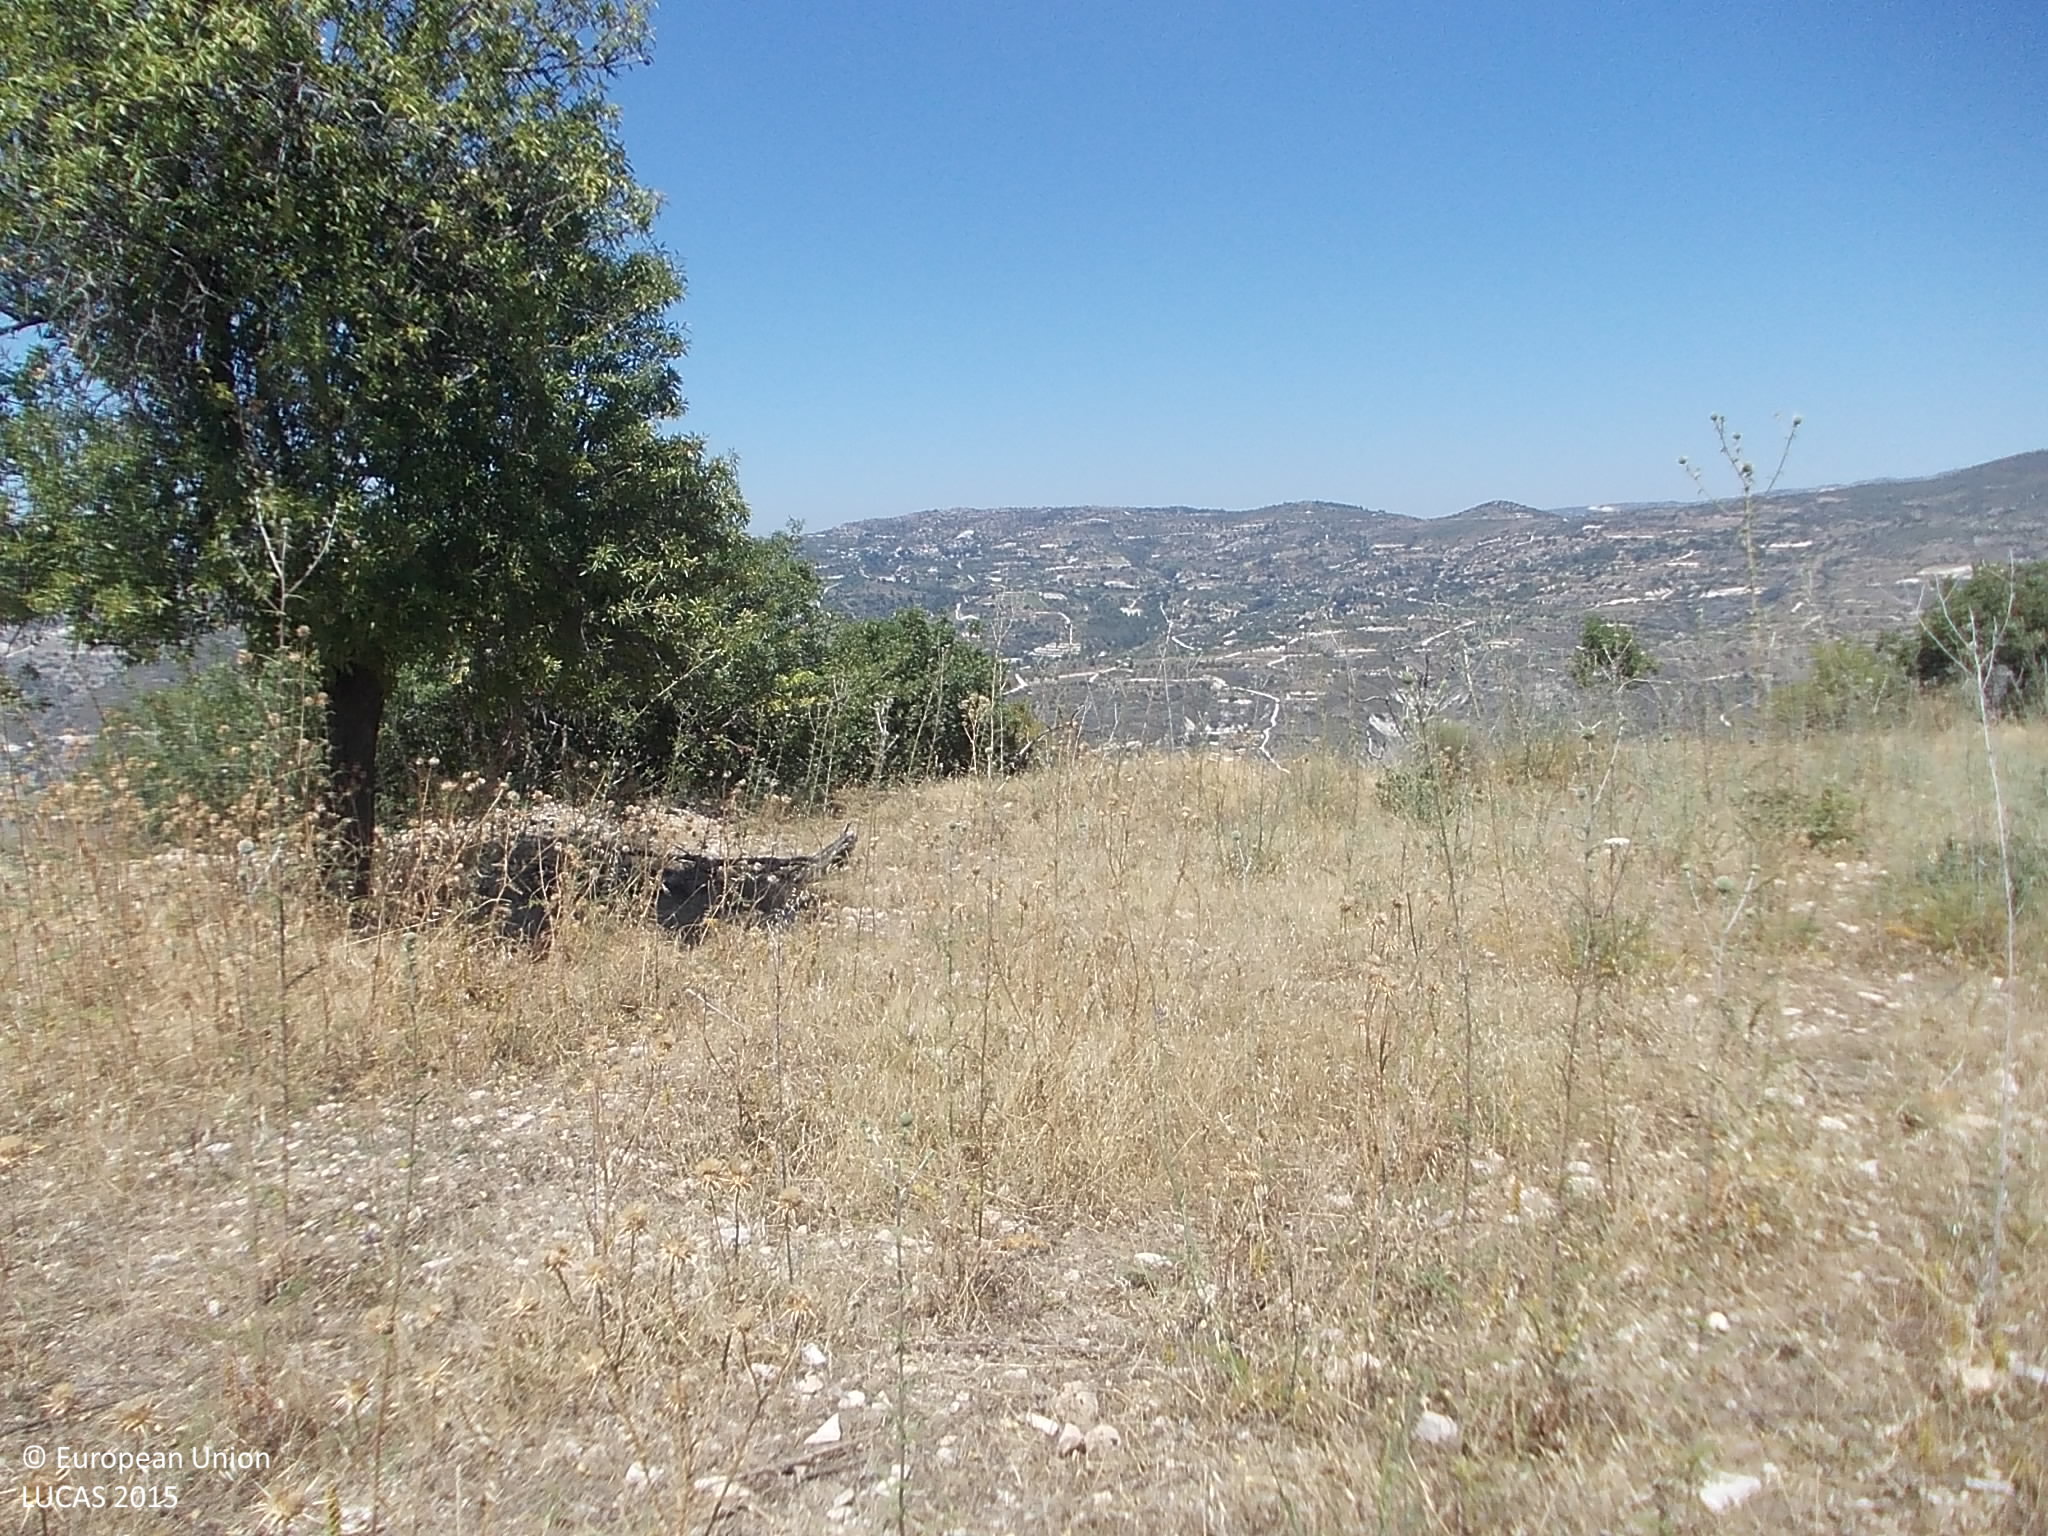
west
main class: Grassland
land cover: Grassland without tree/shrub cover
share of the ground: > 75 %
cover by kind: herbaceous plants 90 %, shrubs 5 %, unconsolidated bare surface 5 %
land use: Semi-natural and natural areas not in use
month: July
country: CY
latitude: 34.8411
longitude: 32.7408
